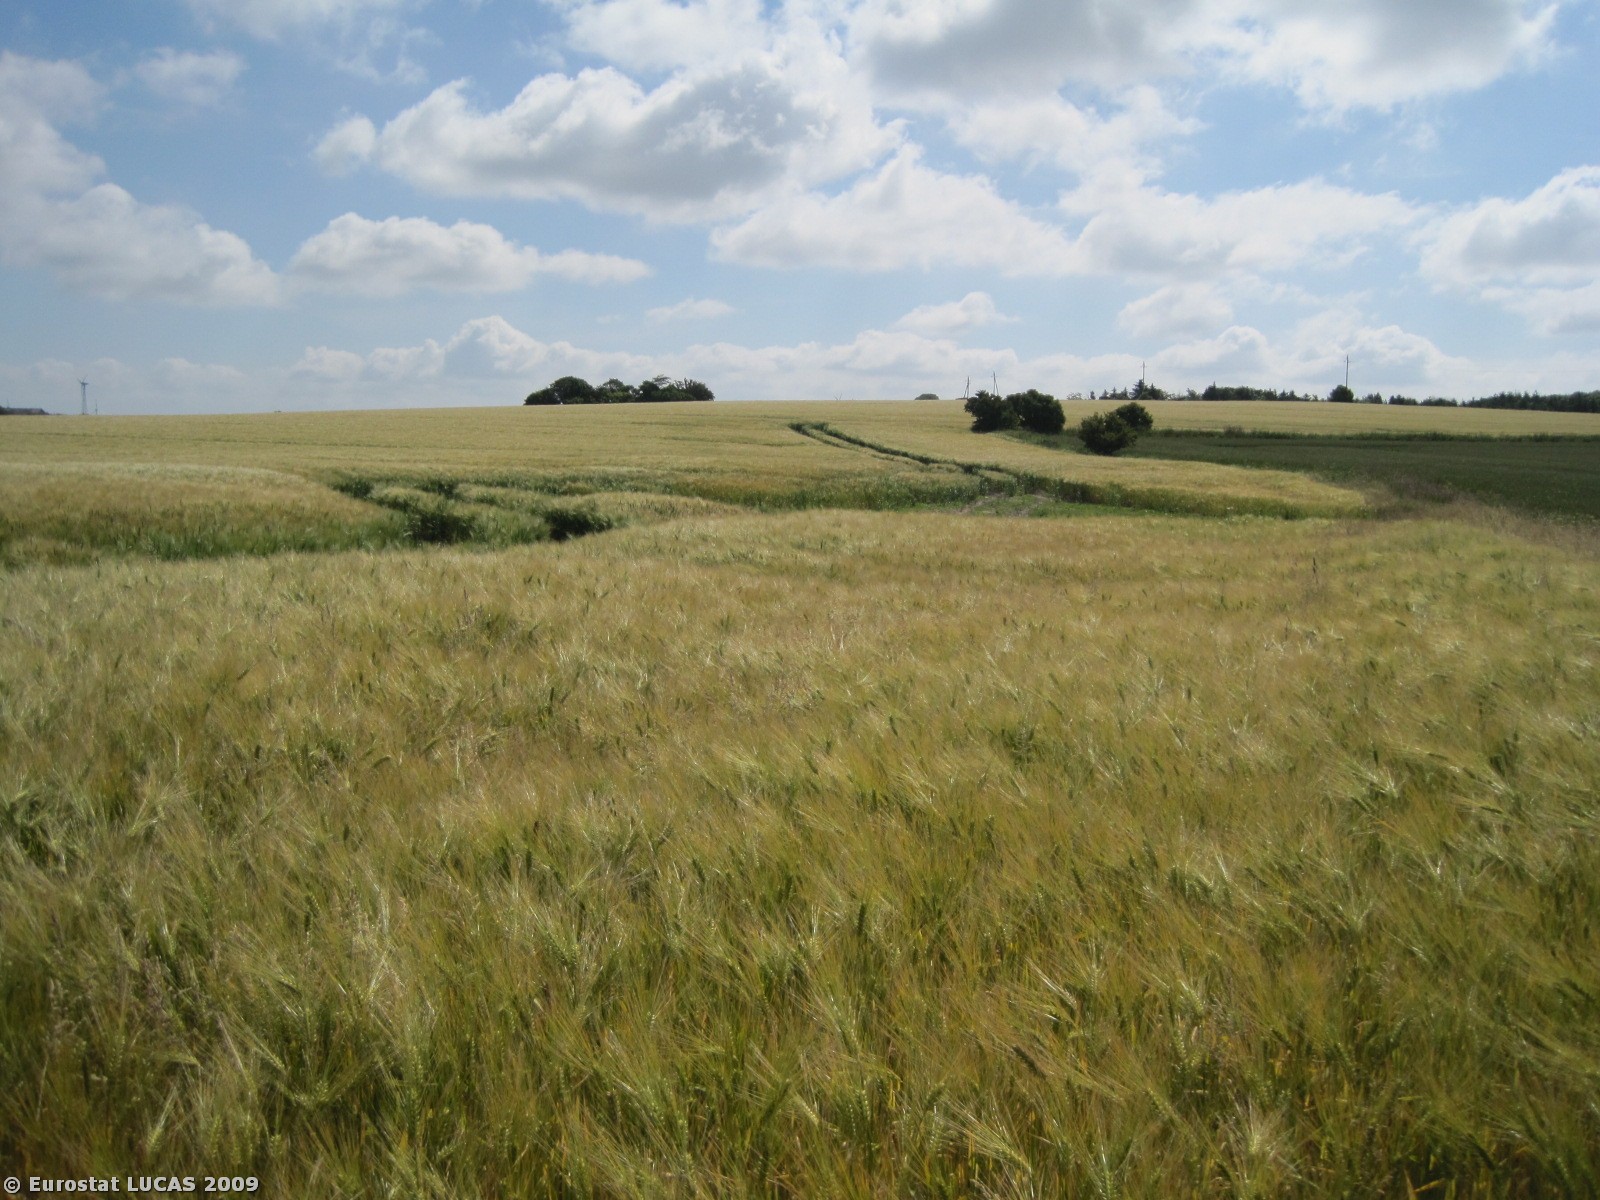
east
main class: Cropland
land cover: Barley
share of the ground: > 75 %
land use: Agriculture (excluding fallow land and kitchen gardens)
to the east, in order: Barley
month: June
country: DK
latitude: 56.7925
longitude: 8.7084
